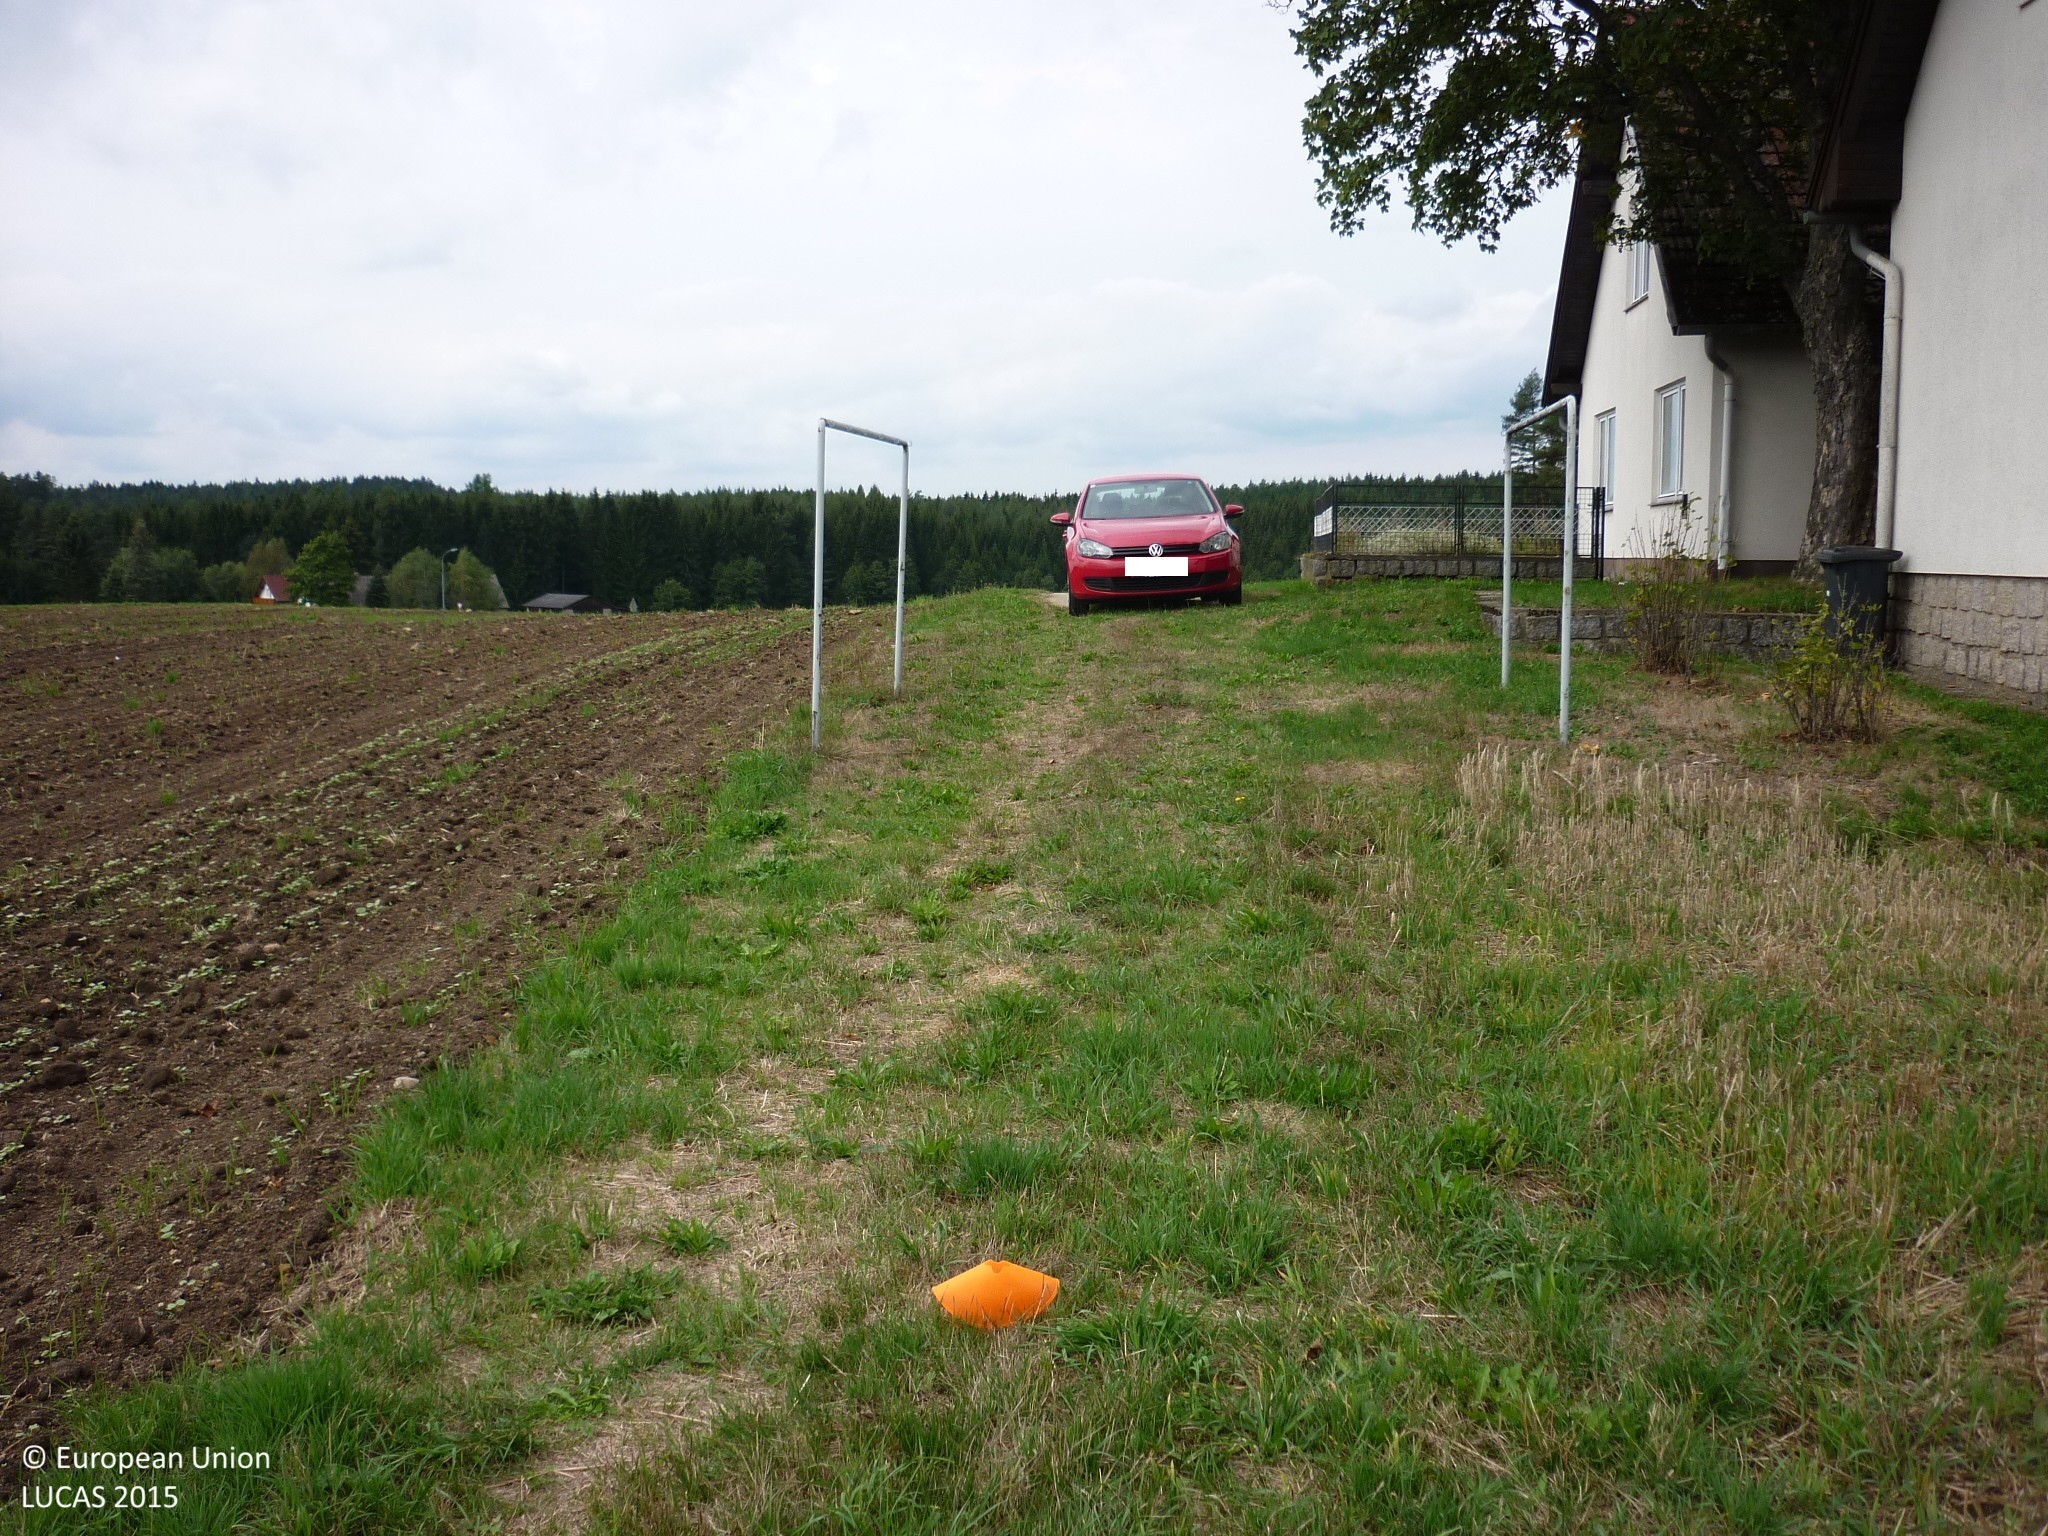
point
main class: Grassland
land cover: Spontaneously vegetated surfaces
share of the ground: 50 - 75 %
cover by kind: herbaceous plants 65 %, unconsolidated bare surface 35 %
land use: Agriculture (excluding fallow land and kitchen gardens)
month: September
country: AT
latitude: 48.8454
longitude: 15.0849
